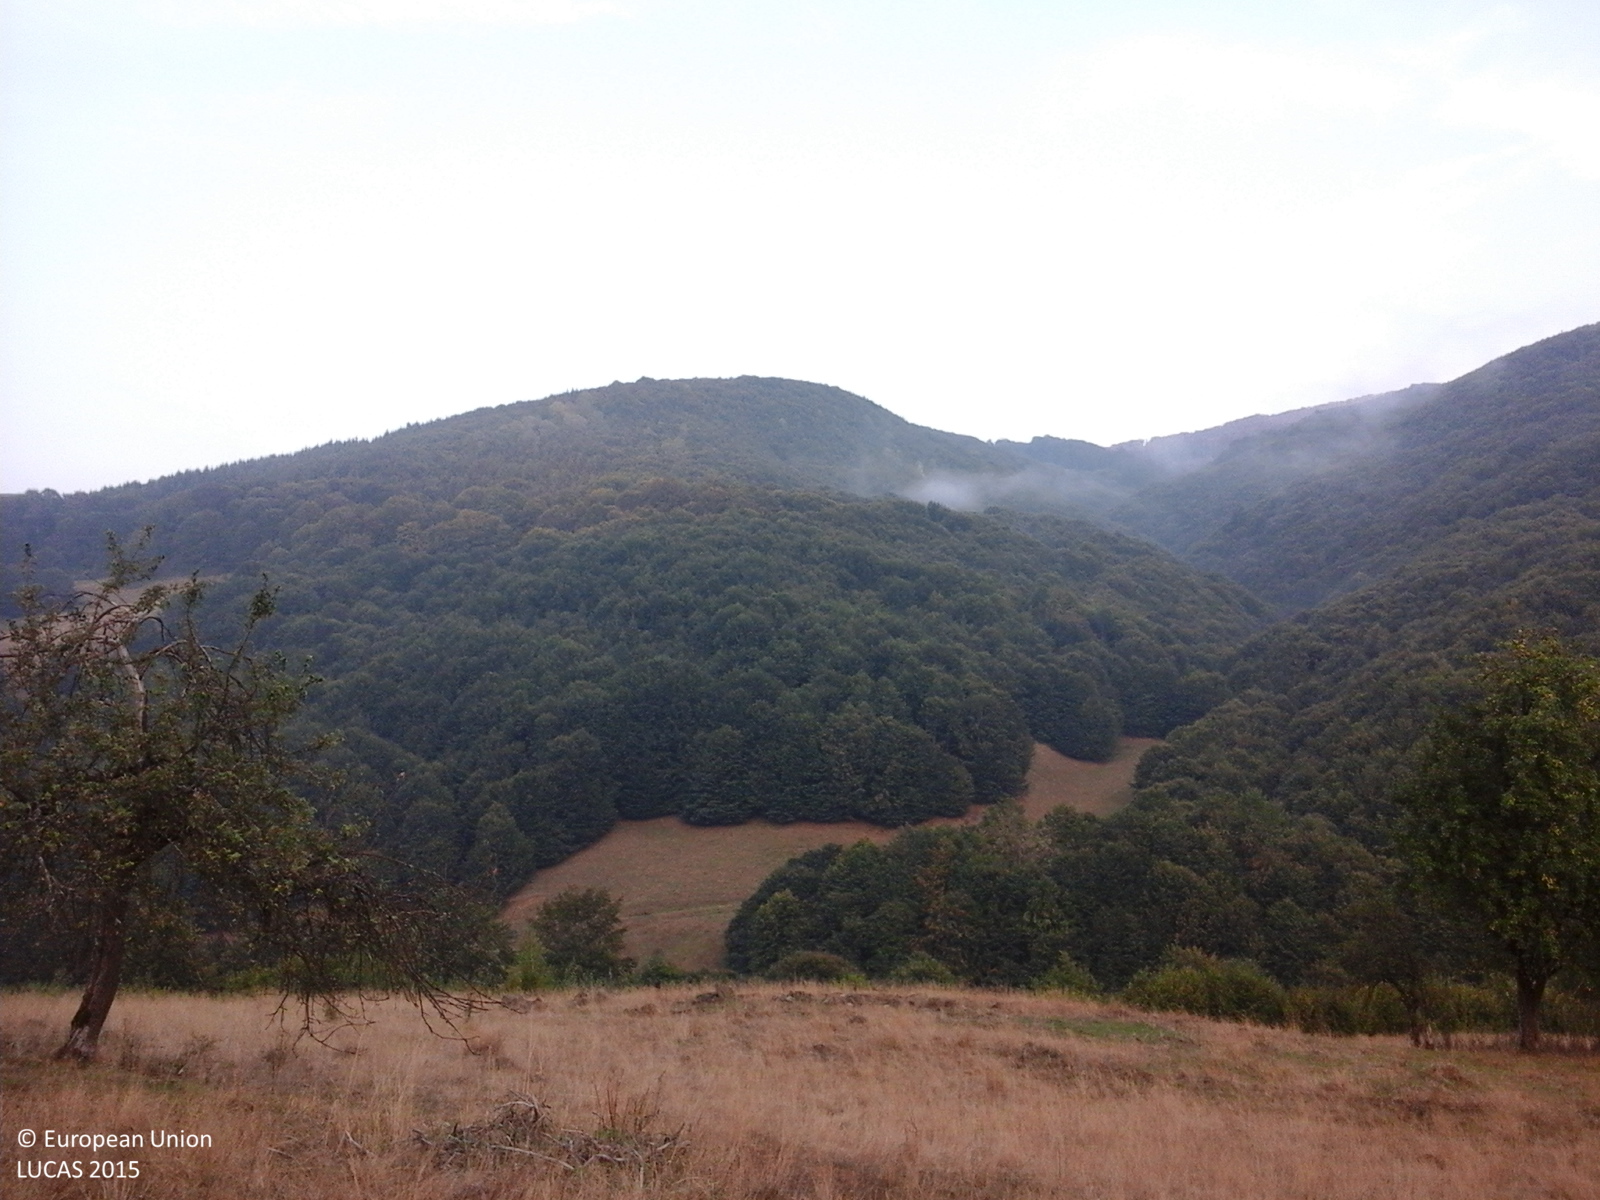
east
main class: Grassland
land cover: Grassland without tree/shrub cover
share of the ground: > 75 %
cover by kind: herbaceous plants 100 %
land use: Agriculture (excluding fallow land and kitchen gardens)
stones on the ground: < 10 %
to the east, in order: Grassland without tree/shrub cover; Grassland with sparse tree/shrub cover; Broadleaved woodland; Grassland without tree/shrub cover; Rivers and streams; Grassland without tree/shrub cover; Tracks; Grassland without tree/shrub cover
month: September
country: RO
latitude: 47.5730
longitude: 24.0564
